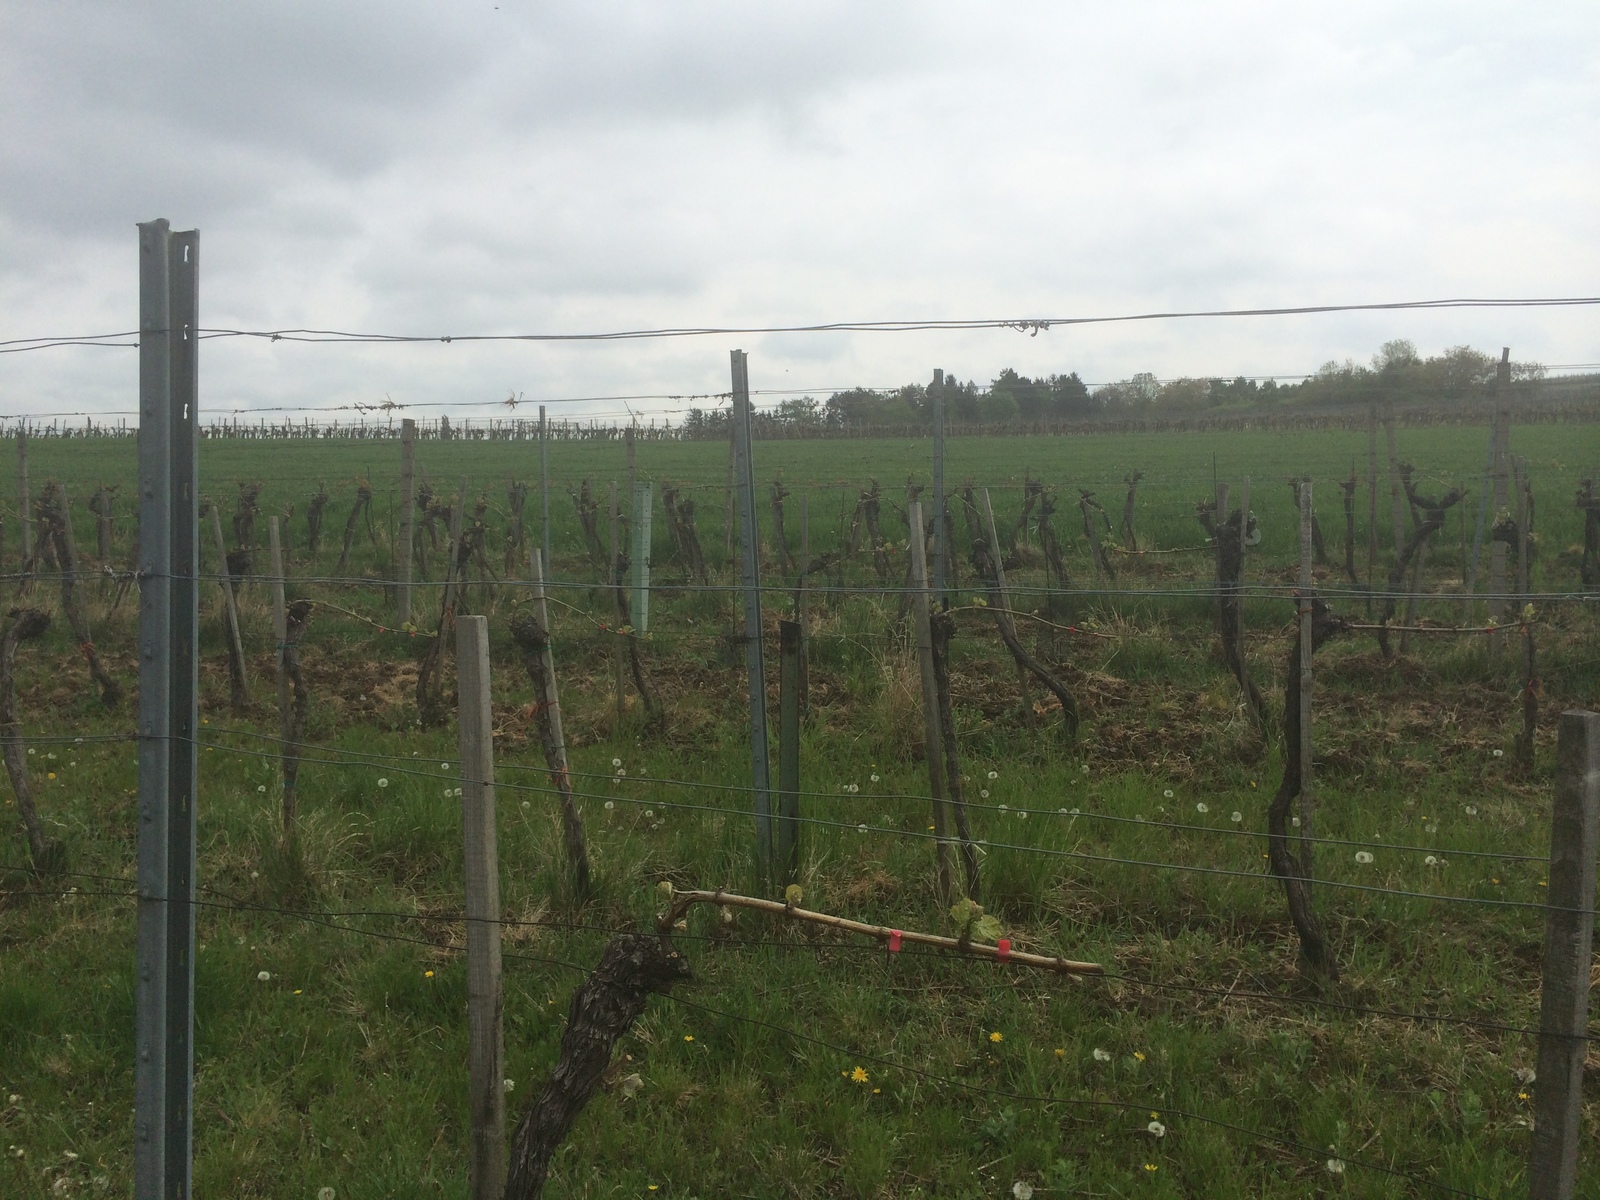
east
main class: Cropland
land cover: Vineyards
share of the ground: 25 - 50 %
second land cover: Spontaneously vegetated surfaces
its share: 50 - 75 %
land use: Agriculture (excluding fallow land and kitchen gardens)
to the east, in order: Vineyards; Spontaneously vegetated surfaces; Barley; Grass margins; Vineyards; Grassland without tree/shrub cover; Vineyards
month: May
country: AT
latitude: 47.9929
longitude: 16.2354
